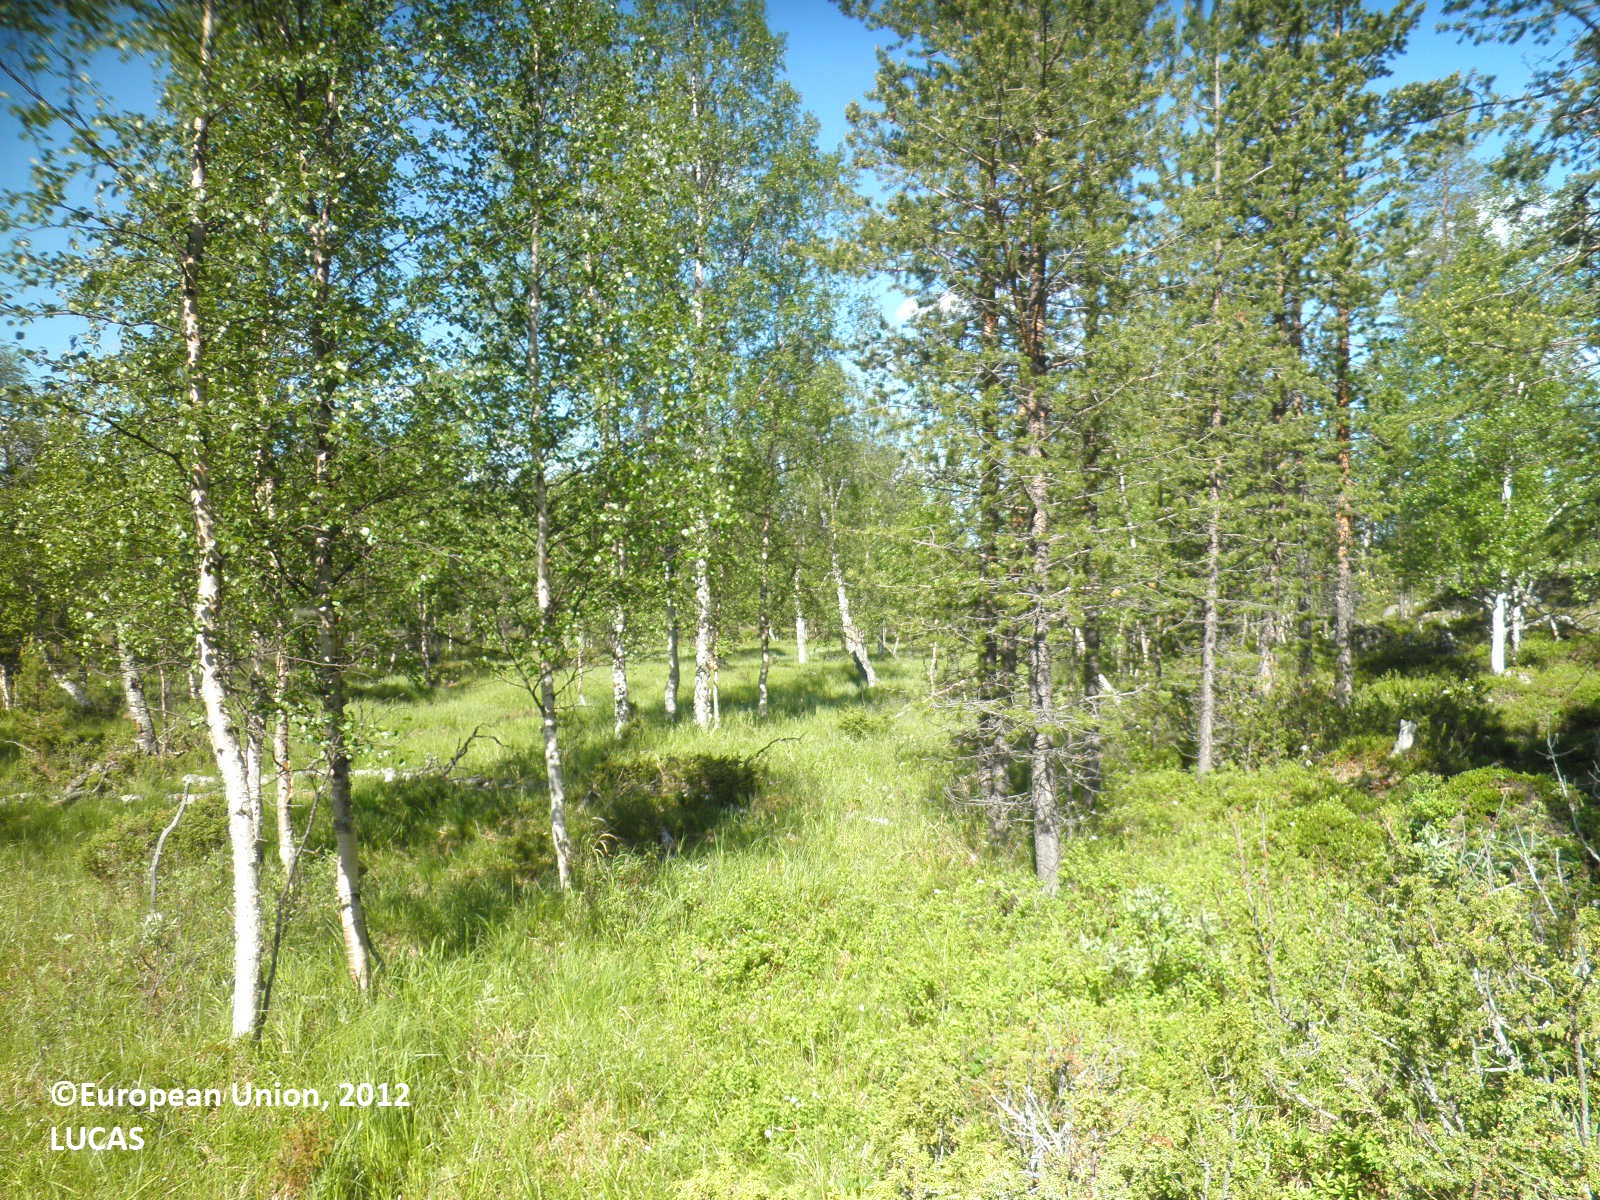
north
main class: Woodland
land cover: Pine dominated mixed woodland
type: boreal forest
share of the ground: 25 - 50 %
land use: Forestry
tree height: > 5 m
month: July
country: FI
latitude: 68.7884
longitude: 26.9251
